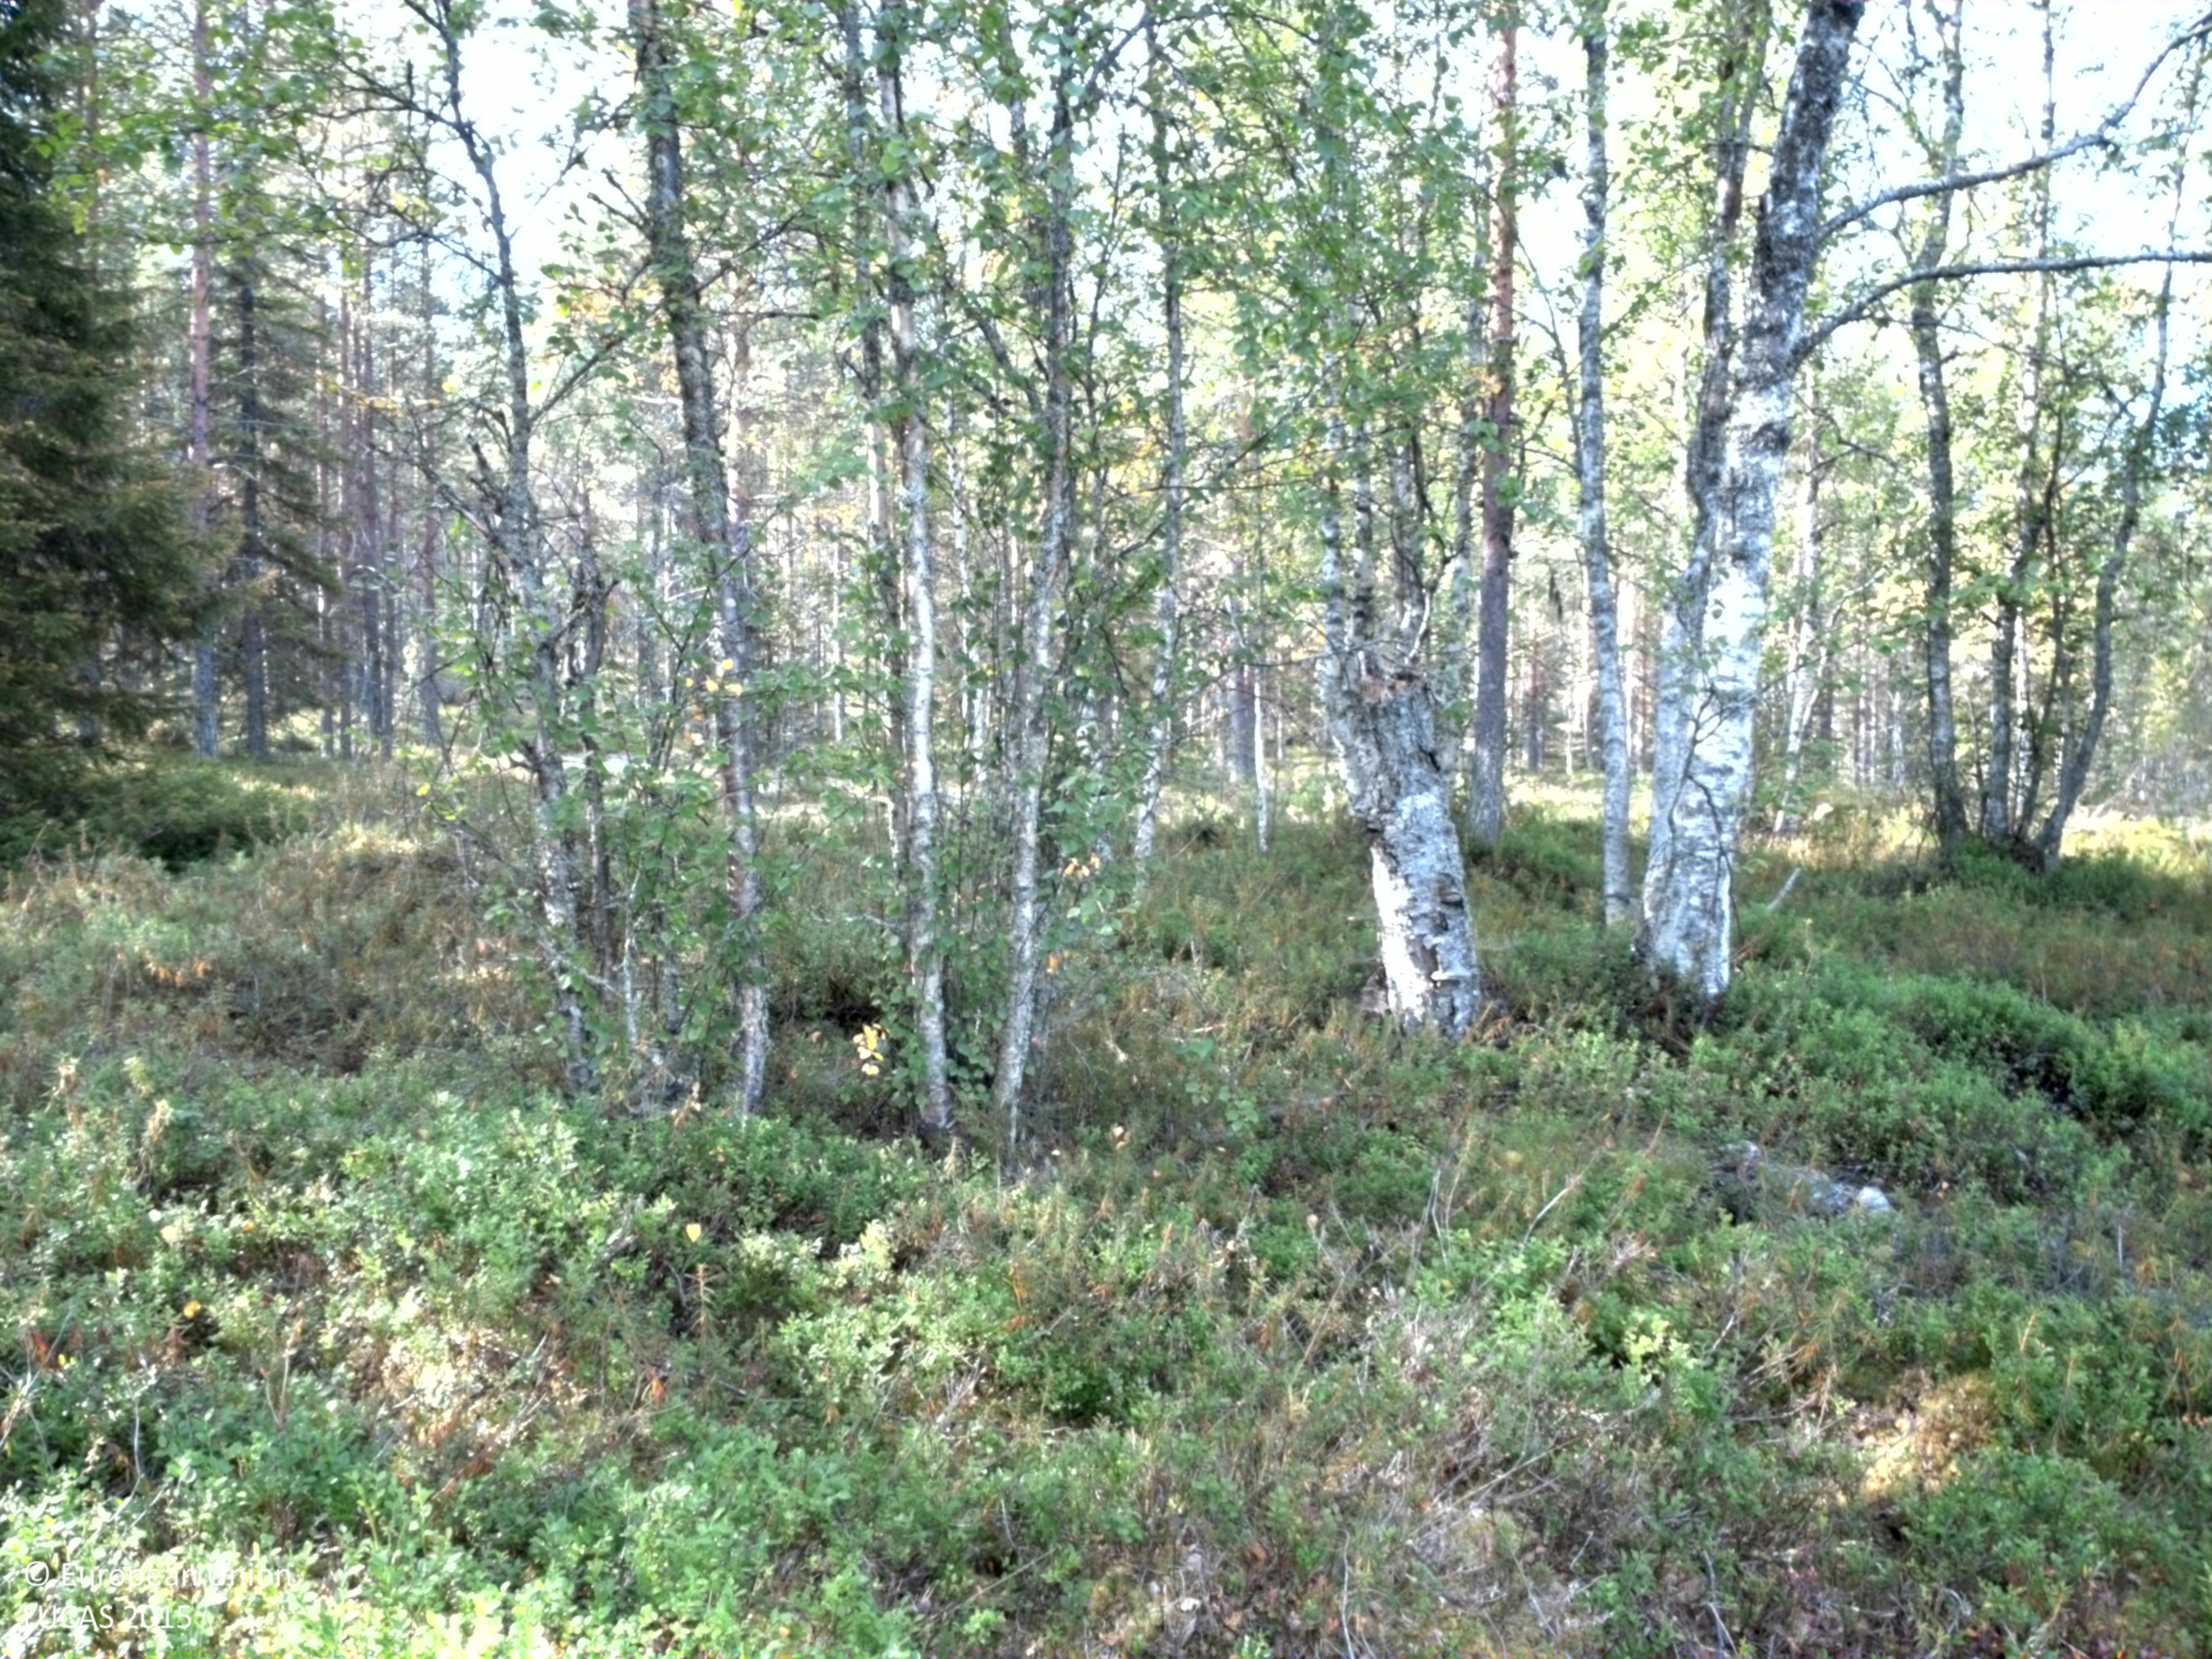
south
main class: Woodland
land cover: Pine dominated mixed woodland
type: boreal forest
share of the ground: 50 - 75 %
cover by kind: coniferous forest trees 45 %, shrubs 30 %, broadleaved forest trees 15 %, lichens and mosses 10 %
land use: Forestry
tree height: > 5 m
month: August
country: SE
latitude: 64.6010
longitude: 18.9329
